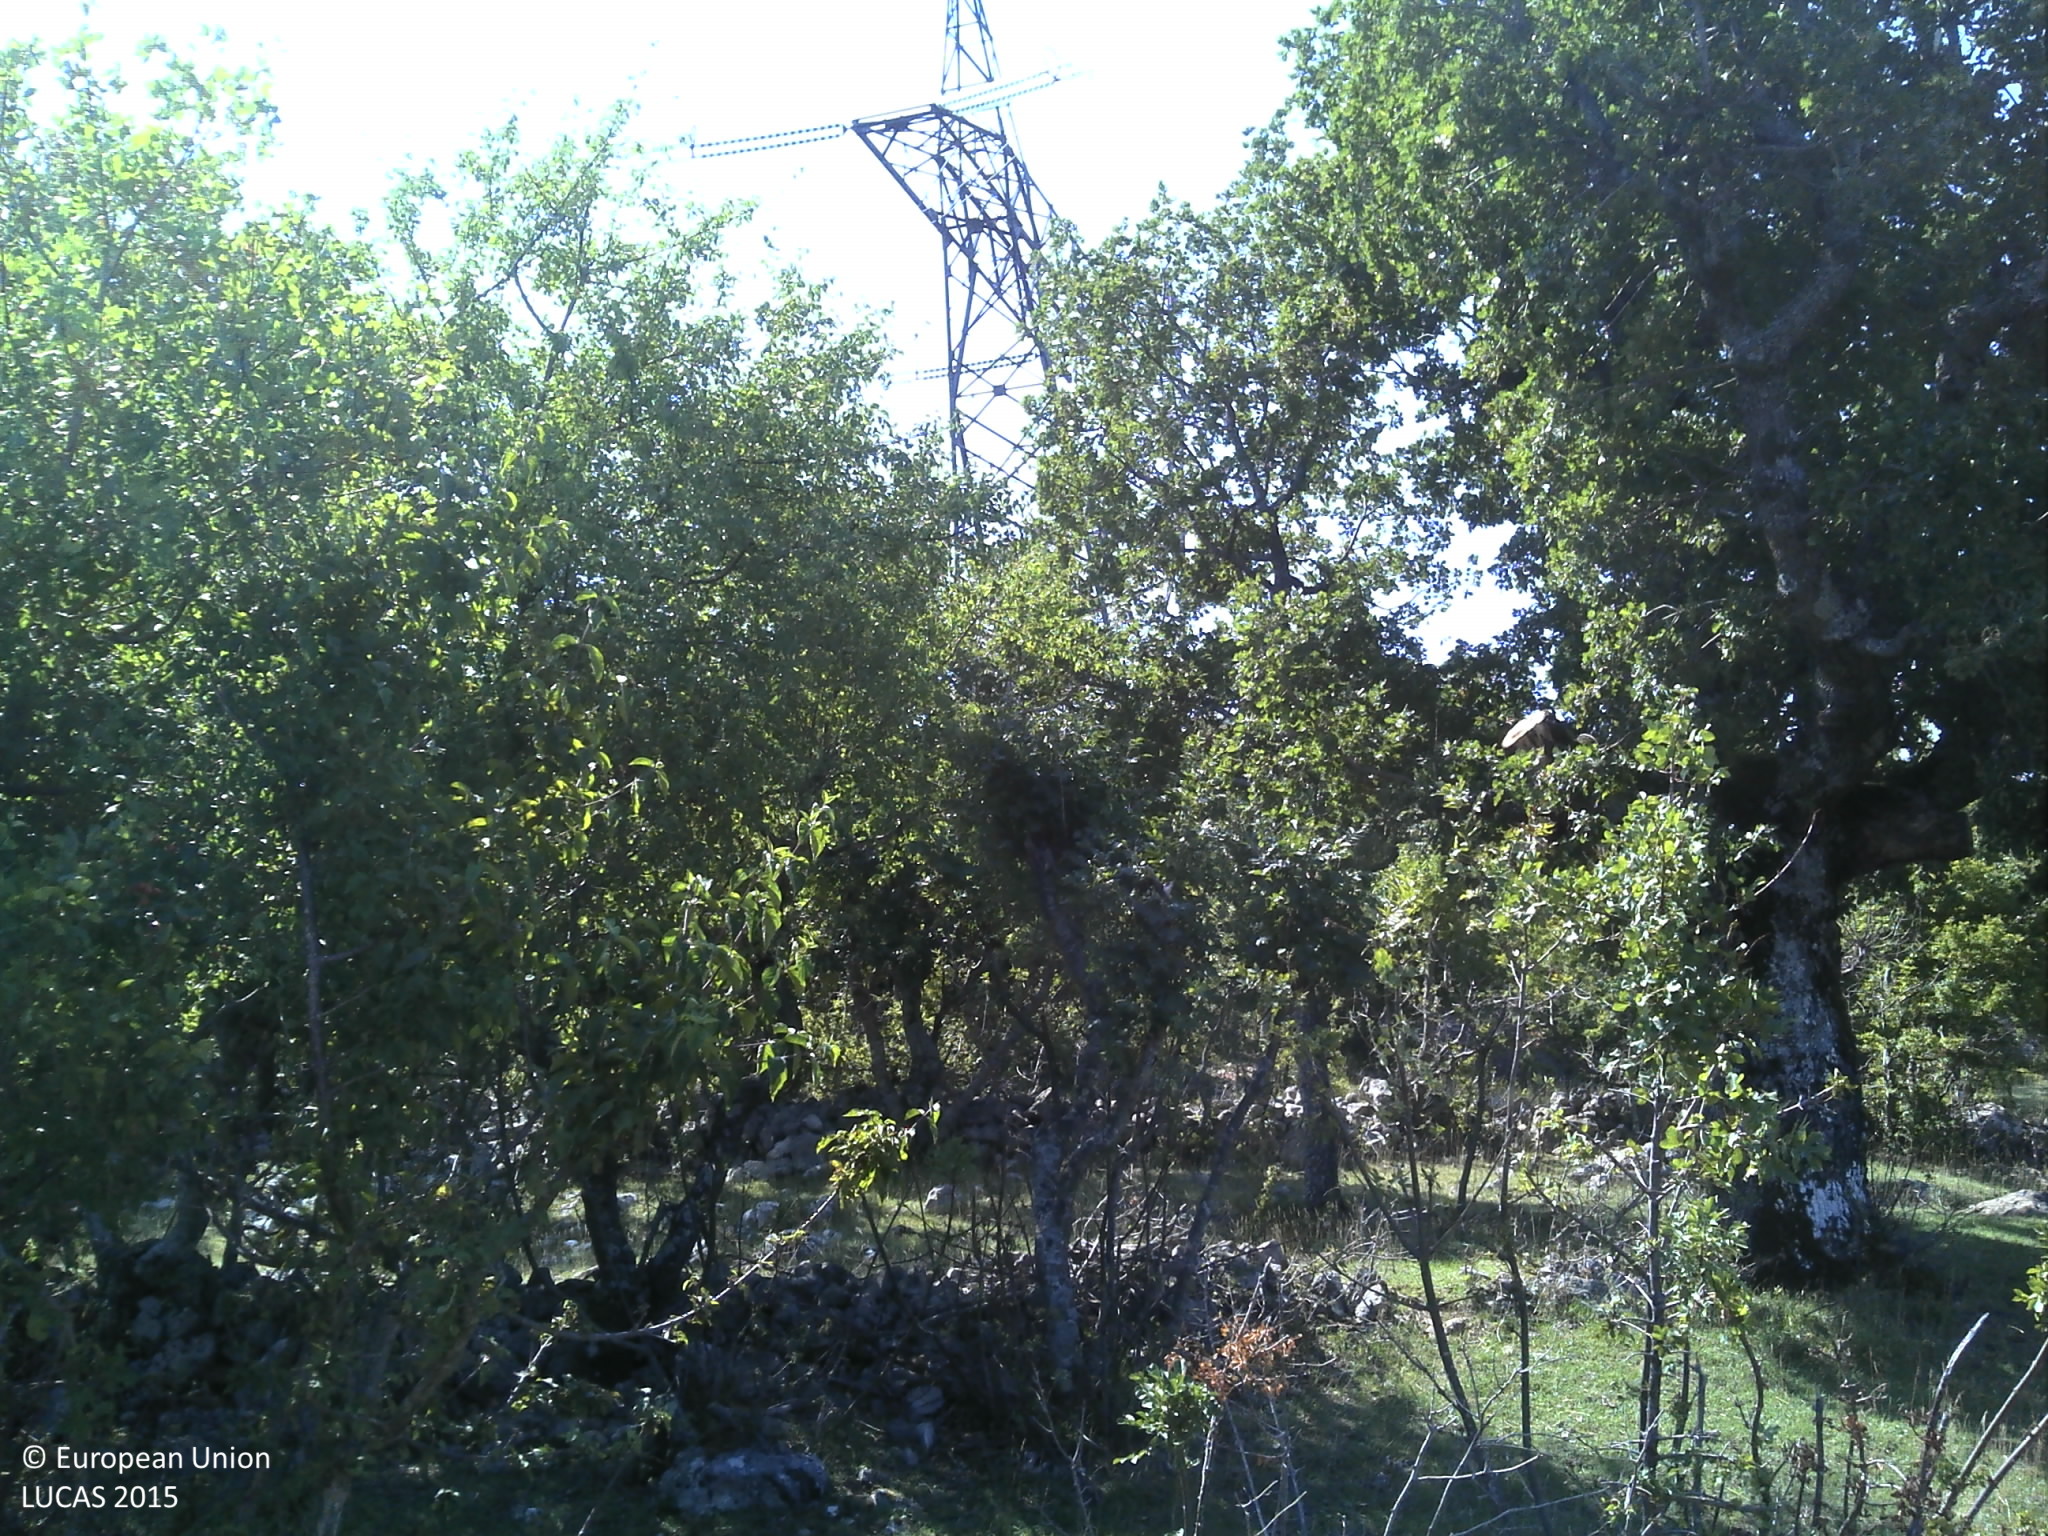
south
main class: Grassland
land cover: Grassland with sparse tree/shrub cover
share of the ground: 50 - 75 %
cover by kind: herbaceous plants 75 %, shrubs 10 %, broadleaved forest trees 5 %, consolidated bare surface 5 %, unconsolidated bare surface 5 %
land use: Agriculture (excluding fallow land and kitchen gardens)
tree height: > 5 m
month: August
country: HR
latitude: 44.2043
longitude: 15.8367
